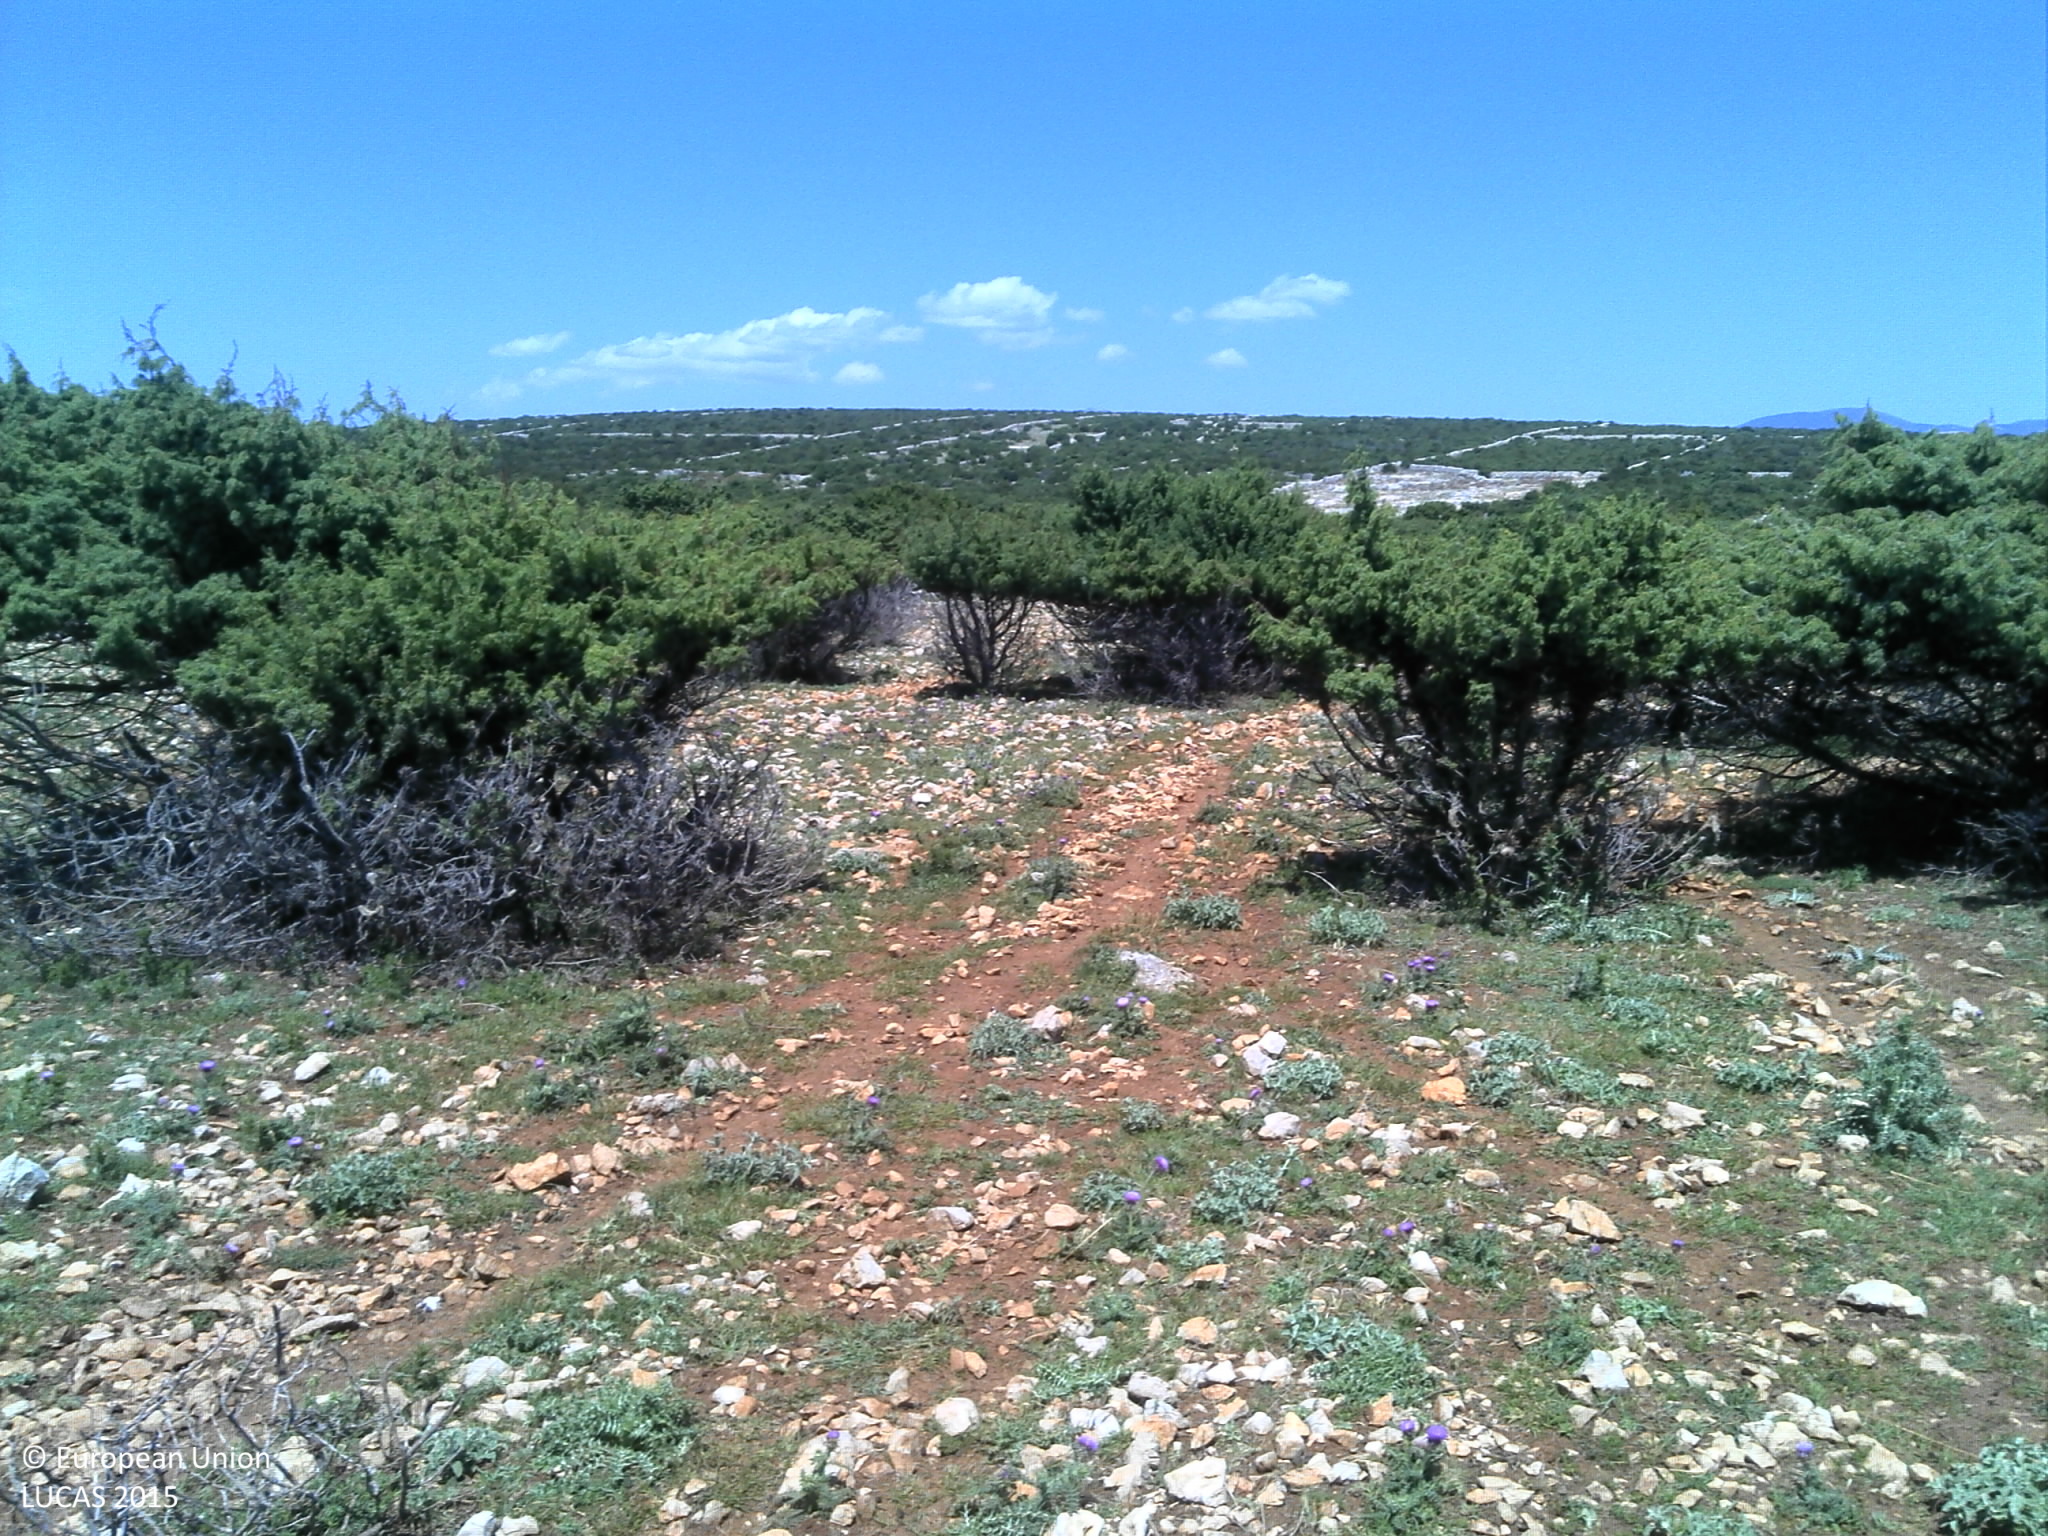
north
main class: Shrubland
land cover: Shrubland without tree cover
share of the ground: 25 - 50 %
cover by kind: unconsolidated bare surface 45 %, herbaceous plants 30 %, shrubs 25 %
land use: Agriculture (excluding fallow land and kitchen gardens)
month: May
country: HR
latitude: 44.4861
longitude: 14.9345
